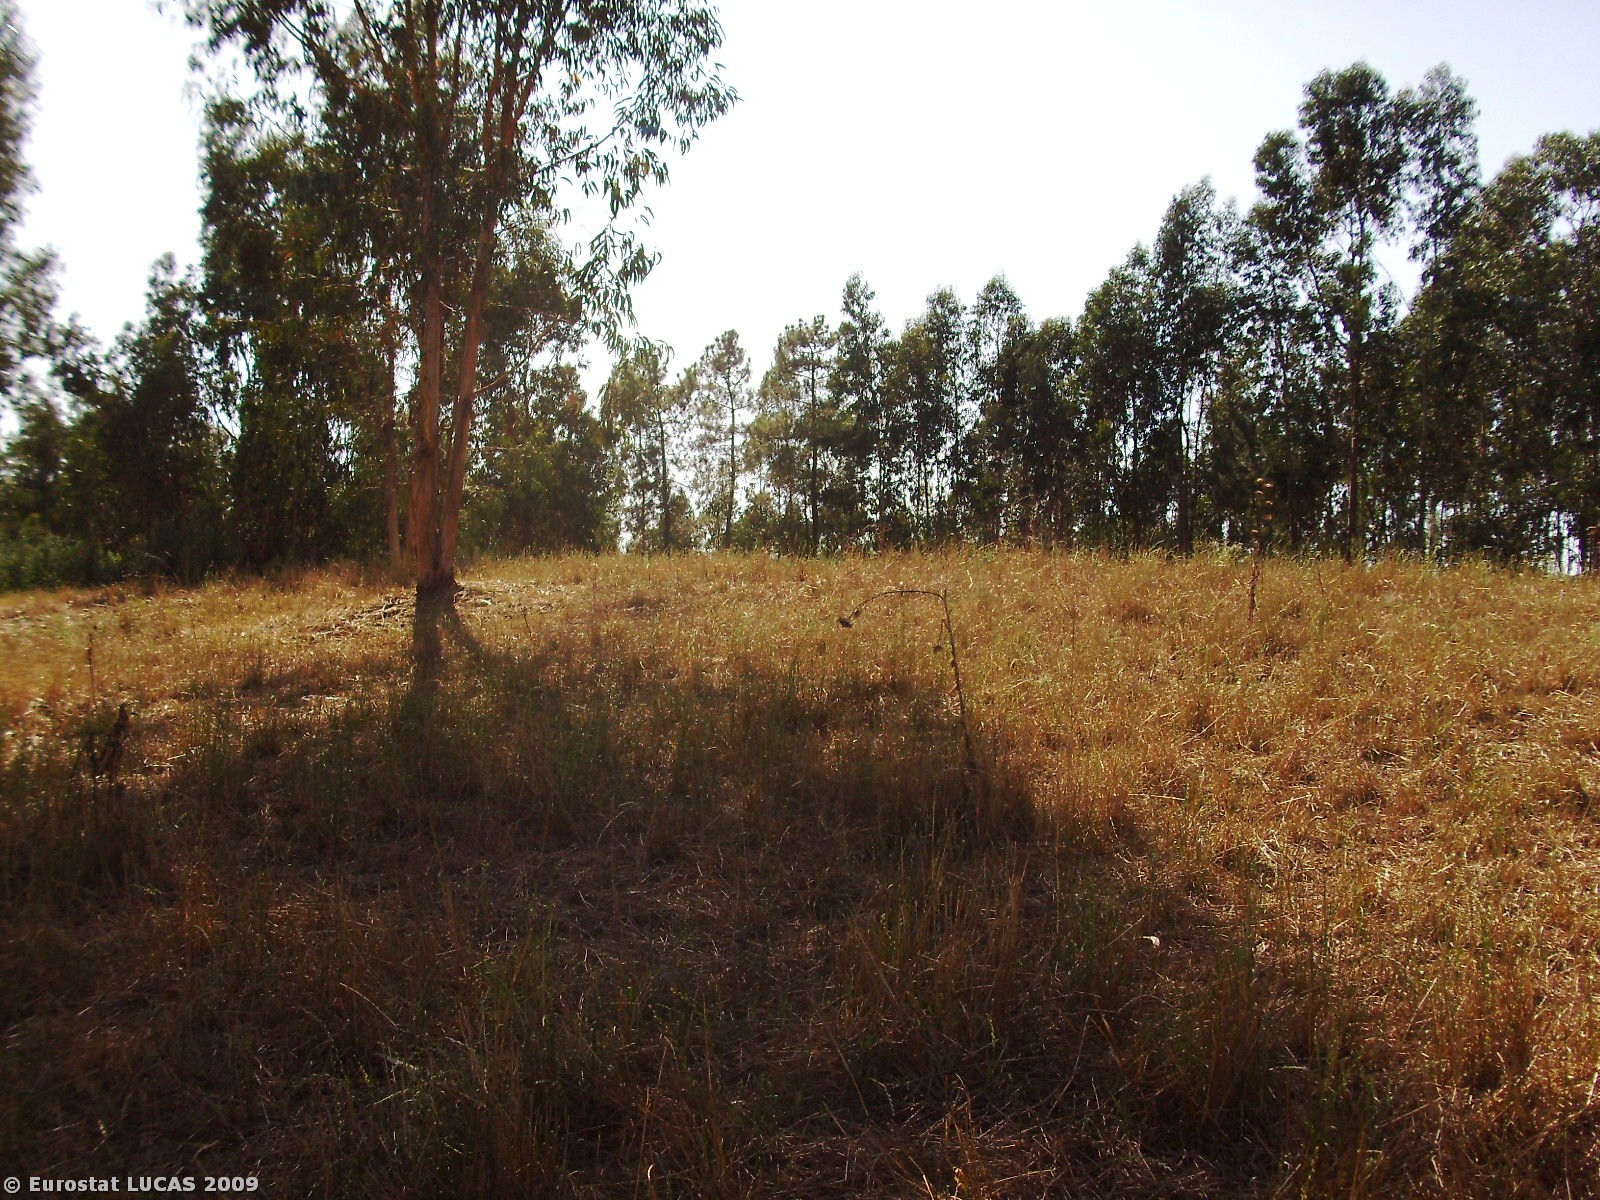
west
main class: Grassland
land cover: Grassland with sparse tree/shrub cover
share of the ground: > 75 %
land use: Agriculture (excluding fallow land and kitchen gardens)
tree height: > 5 m
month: July
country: PT
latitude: 39.3312
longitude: -8.8375
